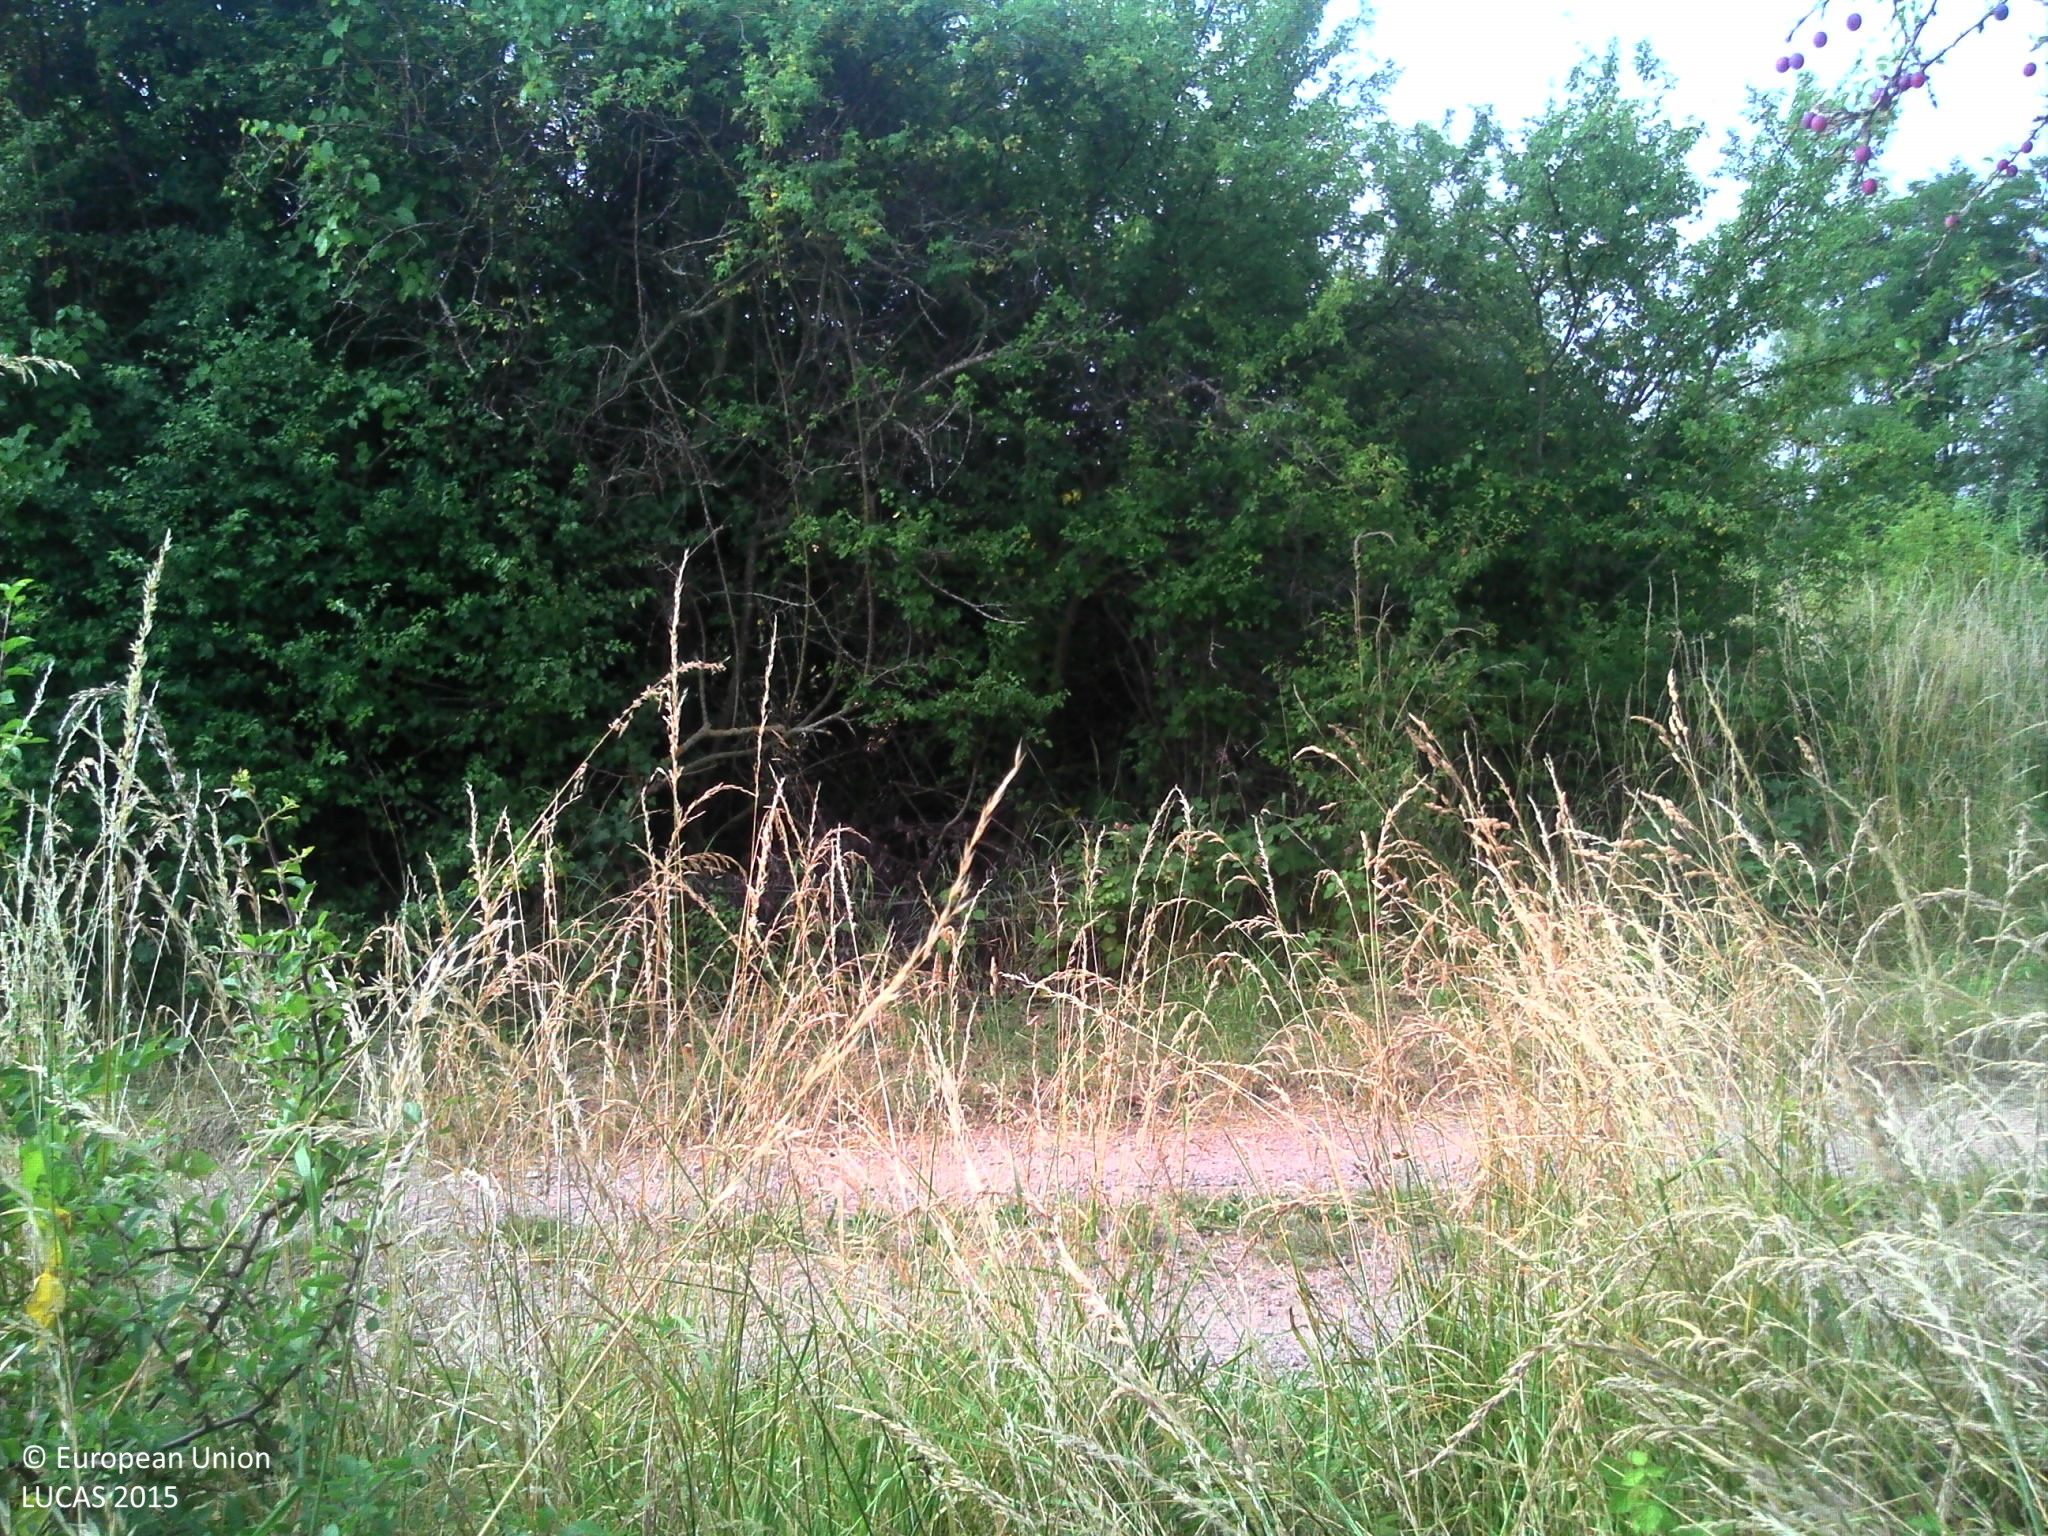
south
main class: Grassland
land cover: Grassland without tree/shrub cover
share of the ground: > 75 %
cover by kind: herbaceous plants 100 %
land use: Semi-natural and natural areas not in use
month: July
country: FR
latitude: 45.9278
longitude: 3.0742
